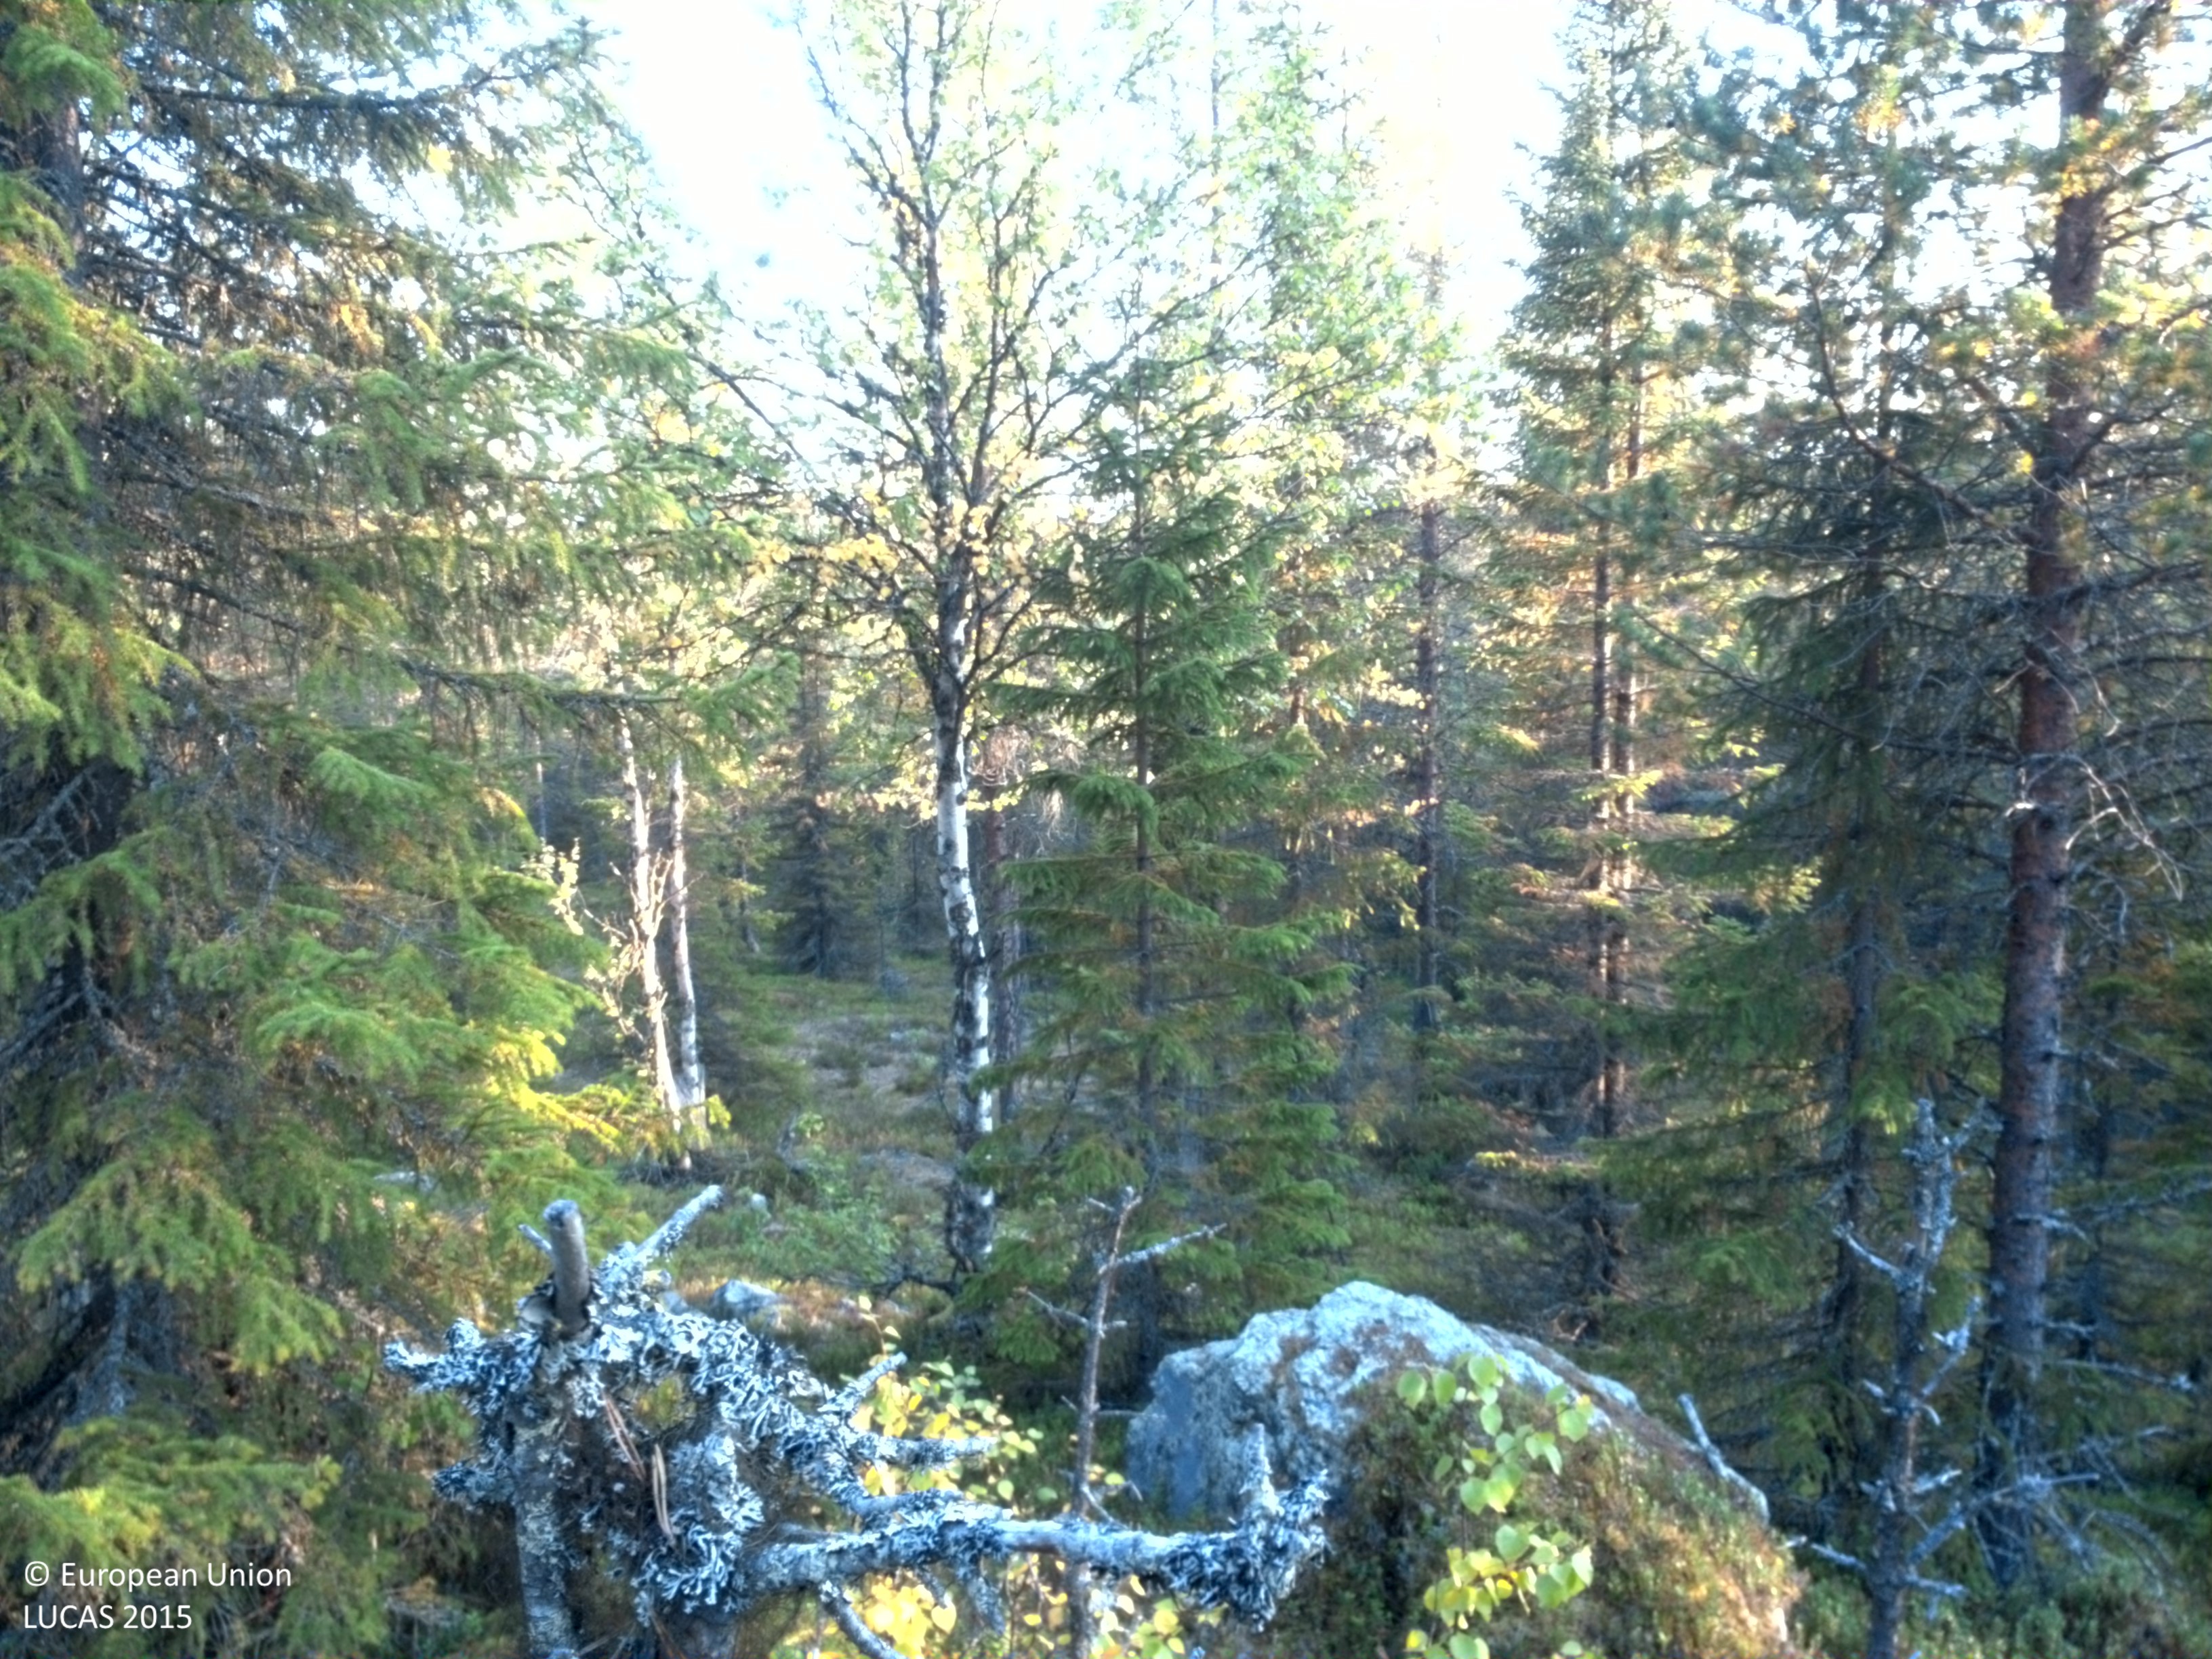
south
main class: Woodland
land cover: Pine dominated coniferous woodland
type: boreal forest
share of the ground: 25 - 50 %
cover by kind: shrubs 45 %, lichens and mosses 30 %, coniferous forest trees 20 %, broadleaved forest trees 5 %
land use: Forestry
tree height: > 5 m
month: September
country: SE
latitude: 65.3489
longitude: 16.6018
